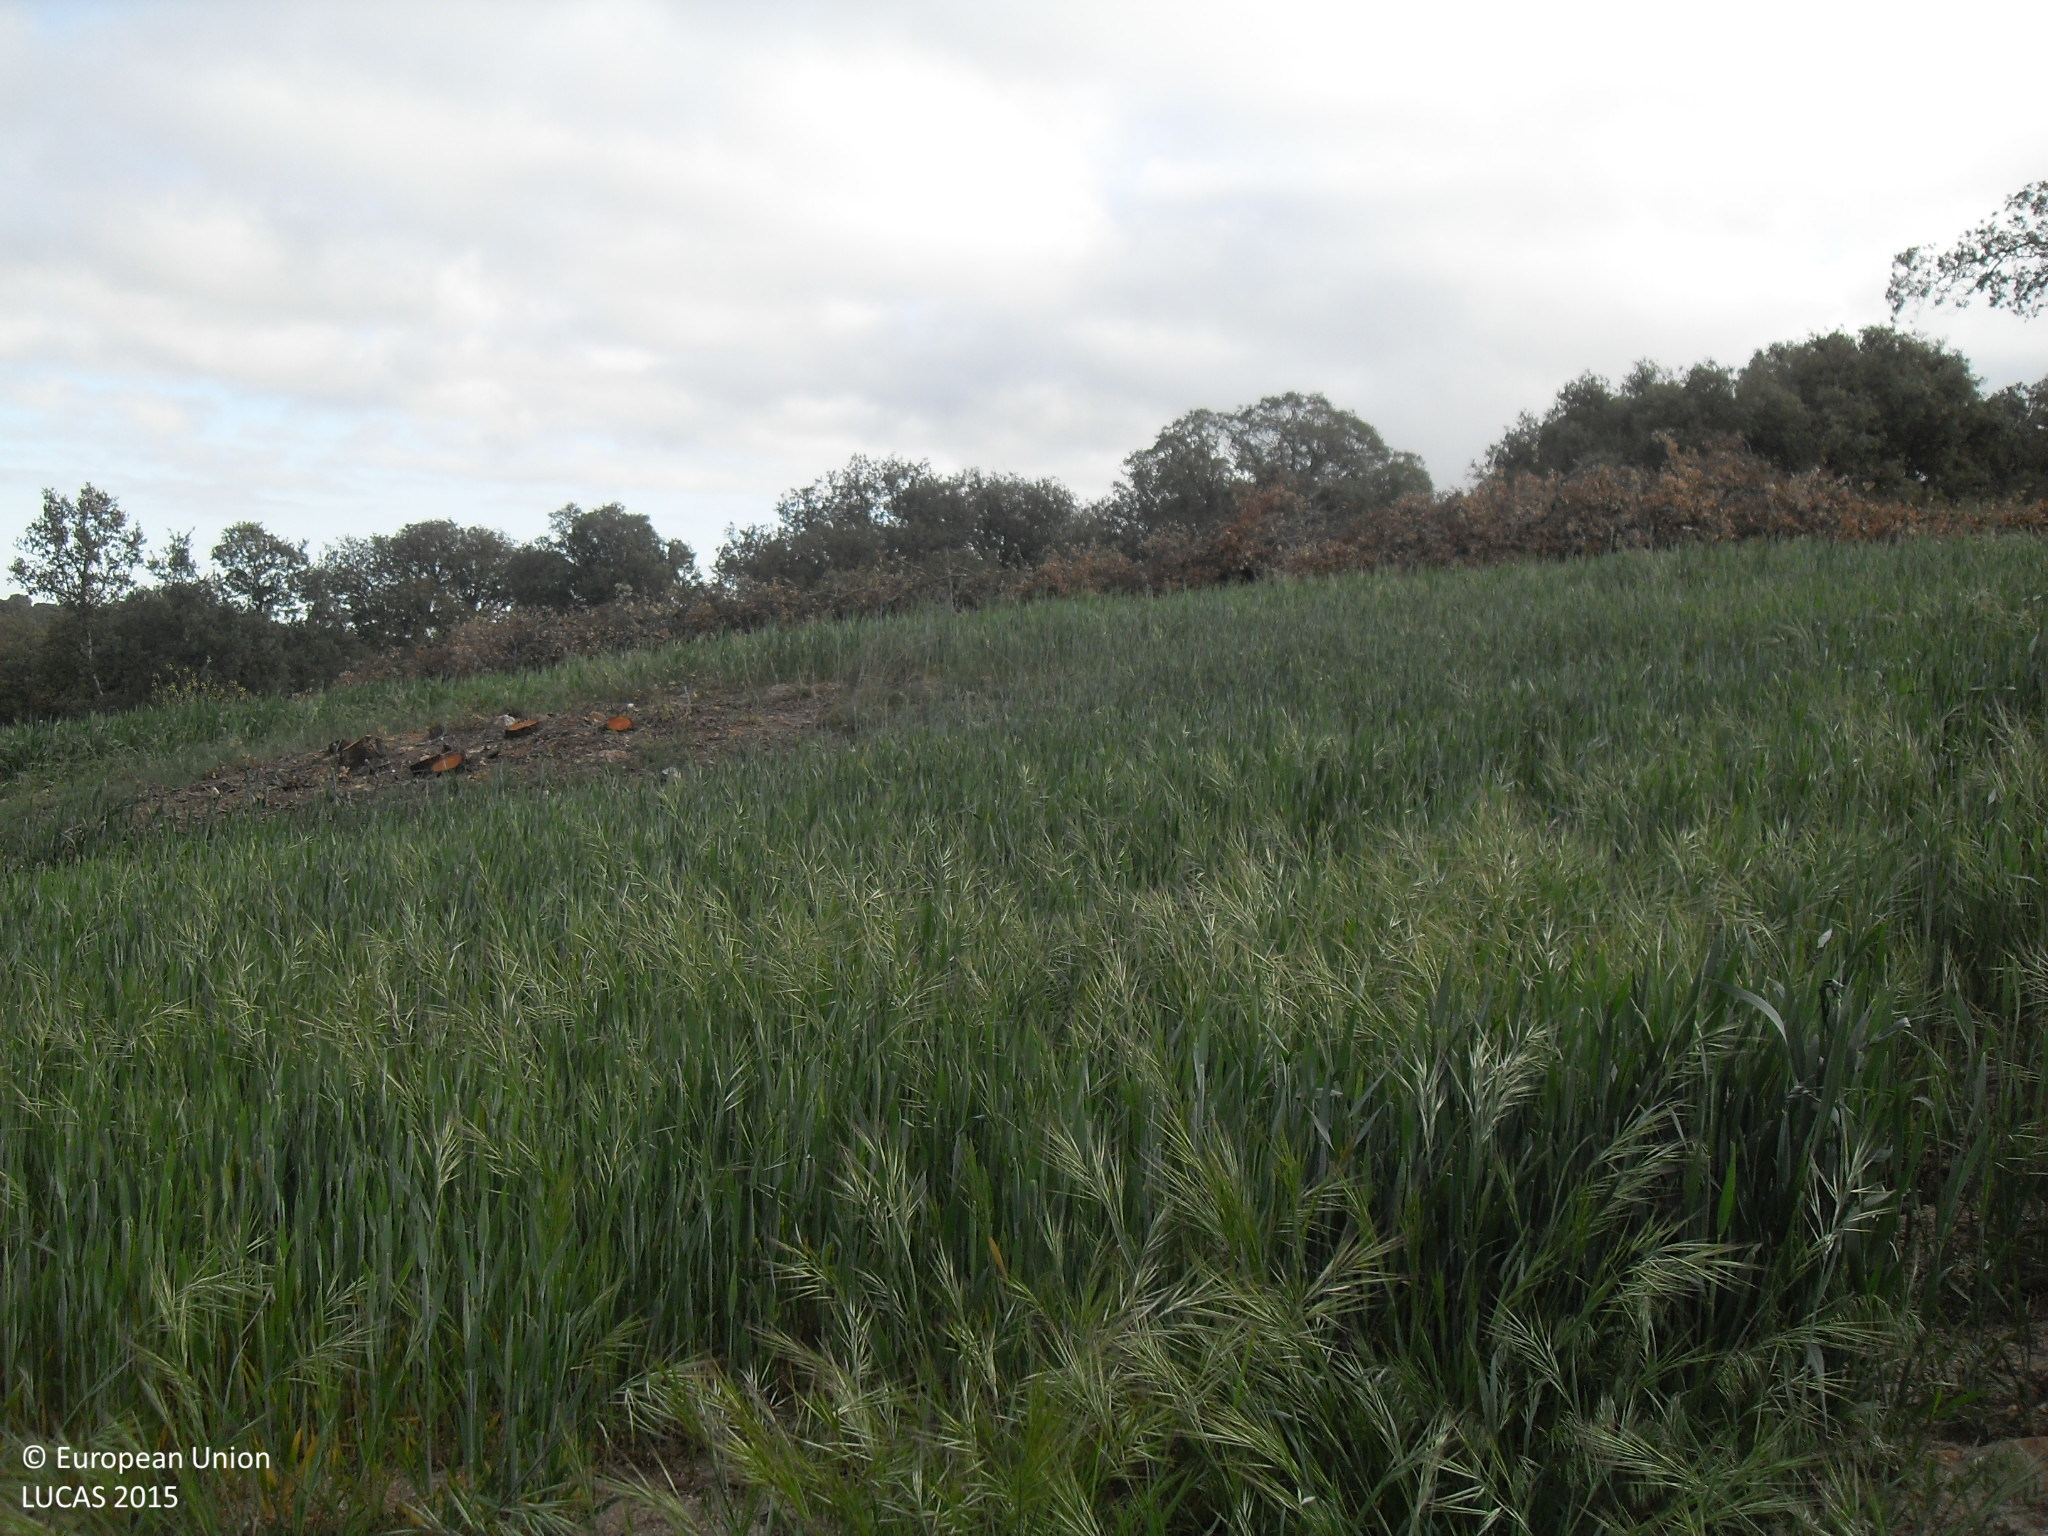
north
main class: Woodland
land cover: Broadleaved woodland
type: broadleaved evergreen forest
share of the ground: 10 - 25 %
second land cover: Grassland without tree/shrub cover
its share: > 75 %
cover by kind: herbaceous plants 85 %, broadleaved forest trees 15 %
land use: Forestry
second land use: Agriculture (excluding fallow land and kitchen gardens)
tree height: > 5 m
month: May
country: ES
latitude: 40.8122
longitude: -5.1327
